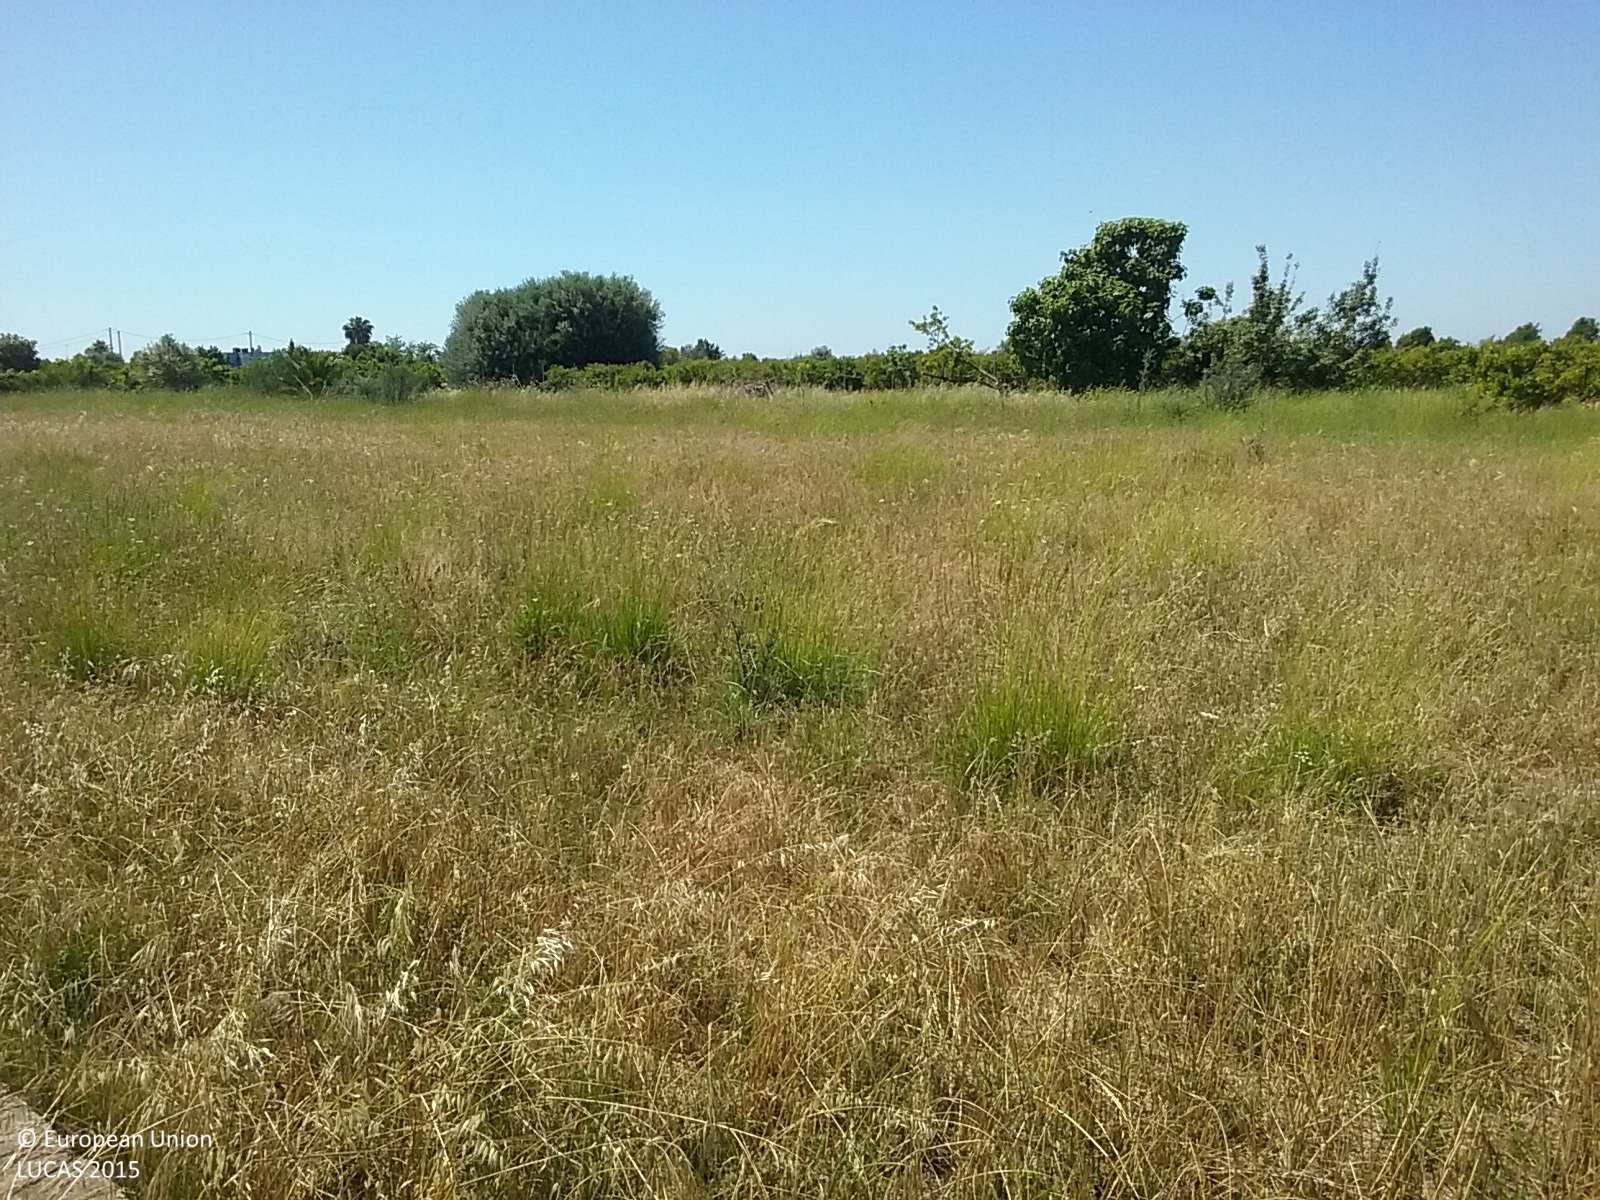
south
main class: Grassland
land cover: Grassland without tree/shrub cover
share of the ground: > 75 %
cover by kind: herbaceous plants 95 %, unconsolidated bare surface 5 %
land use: Abandoned areas
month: June
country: ES
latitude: 39.8530
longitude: -0.1103
